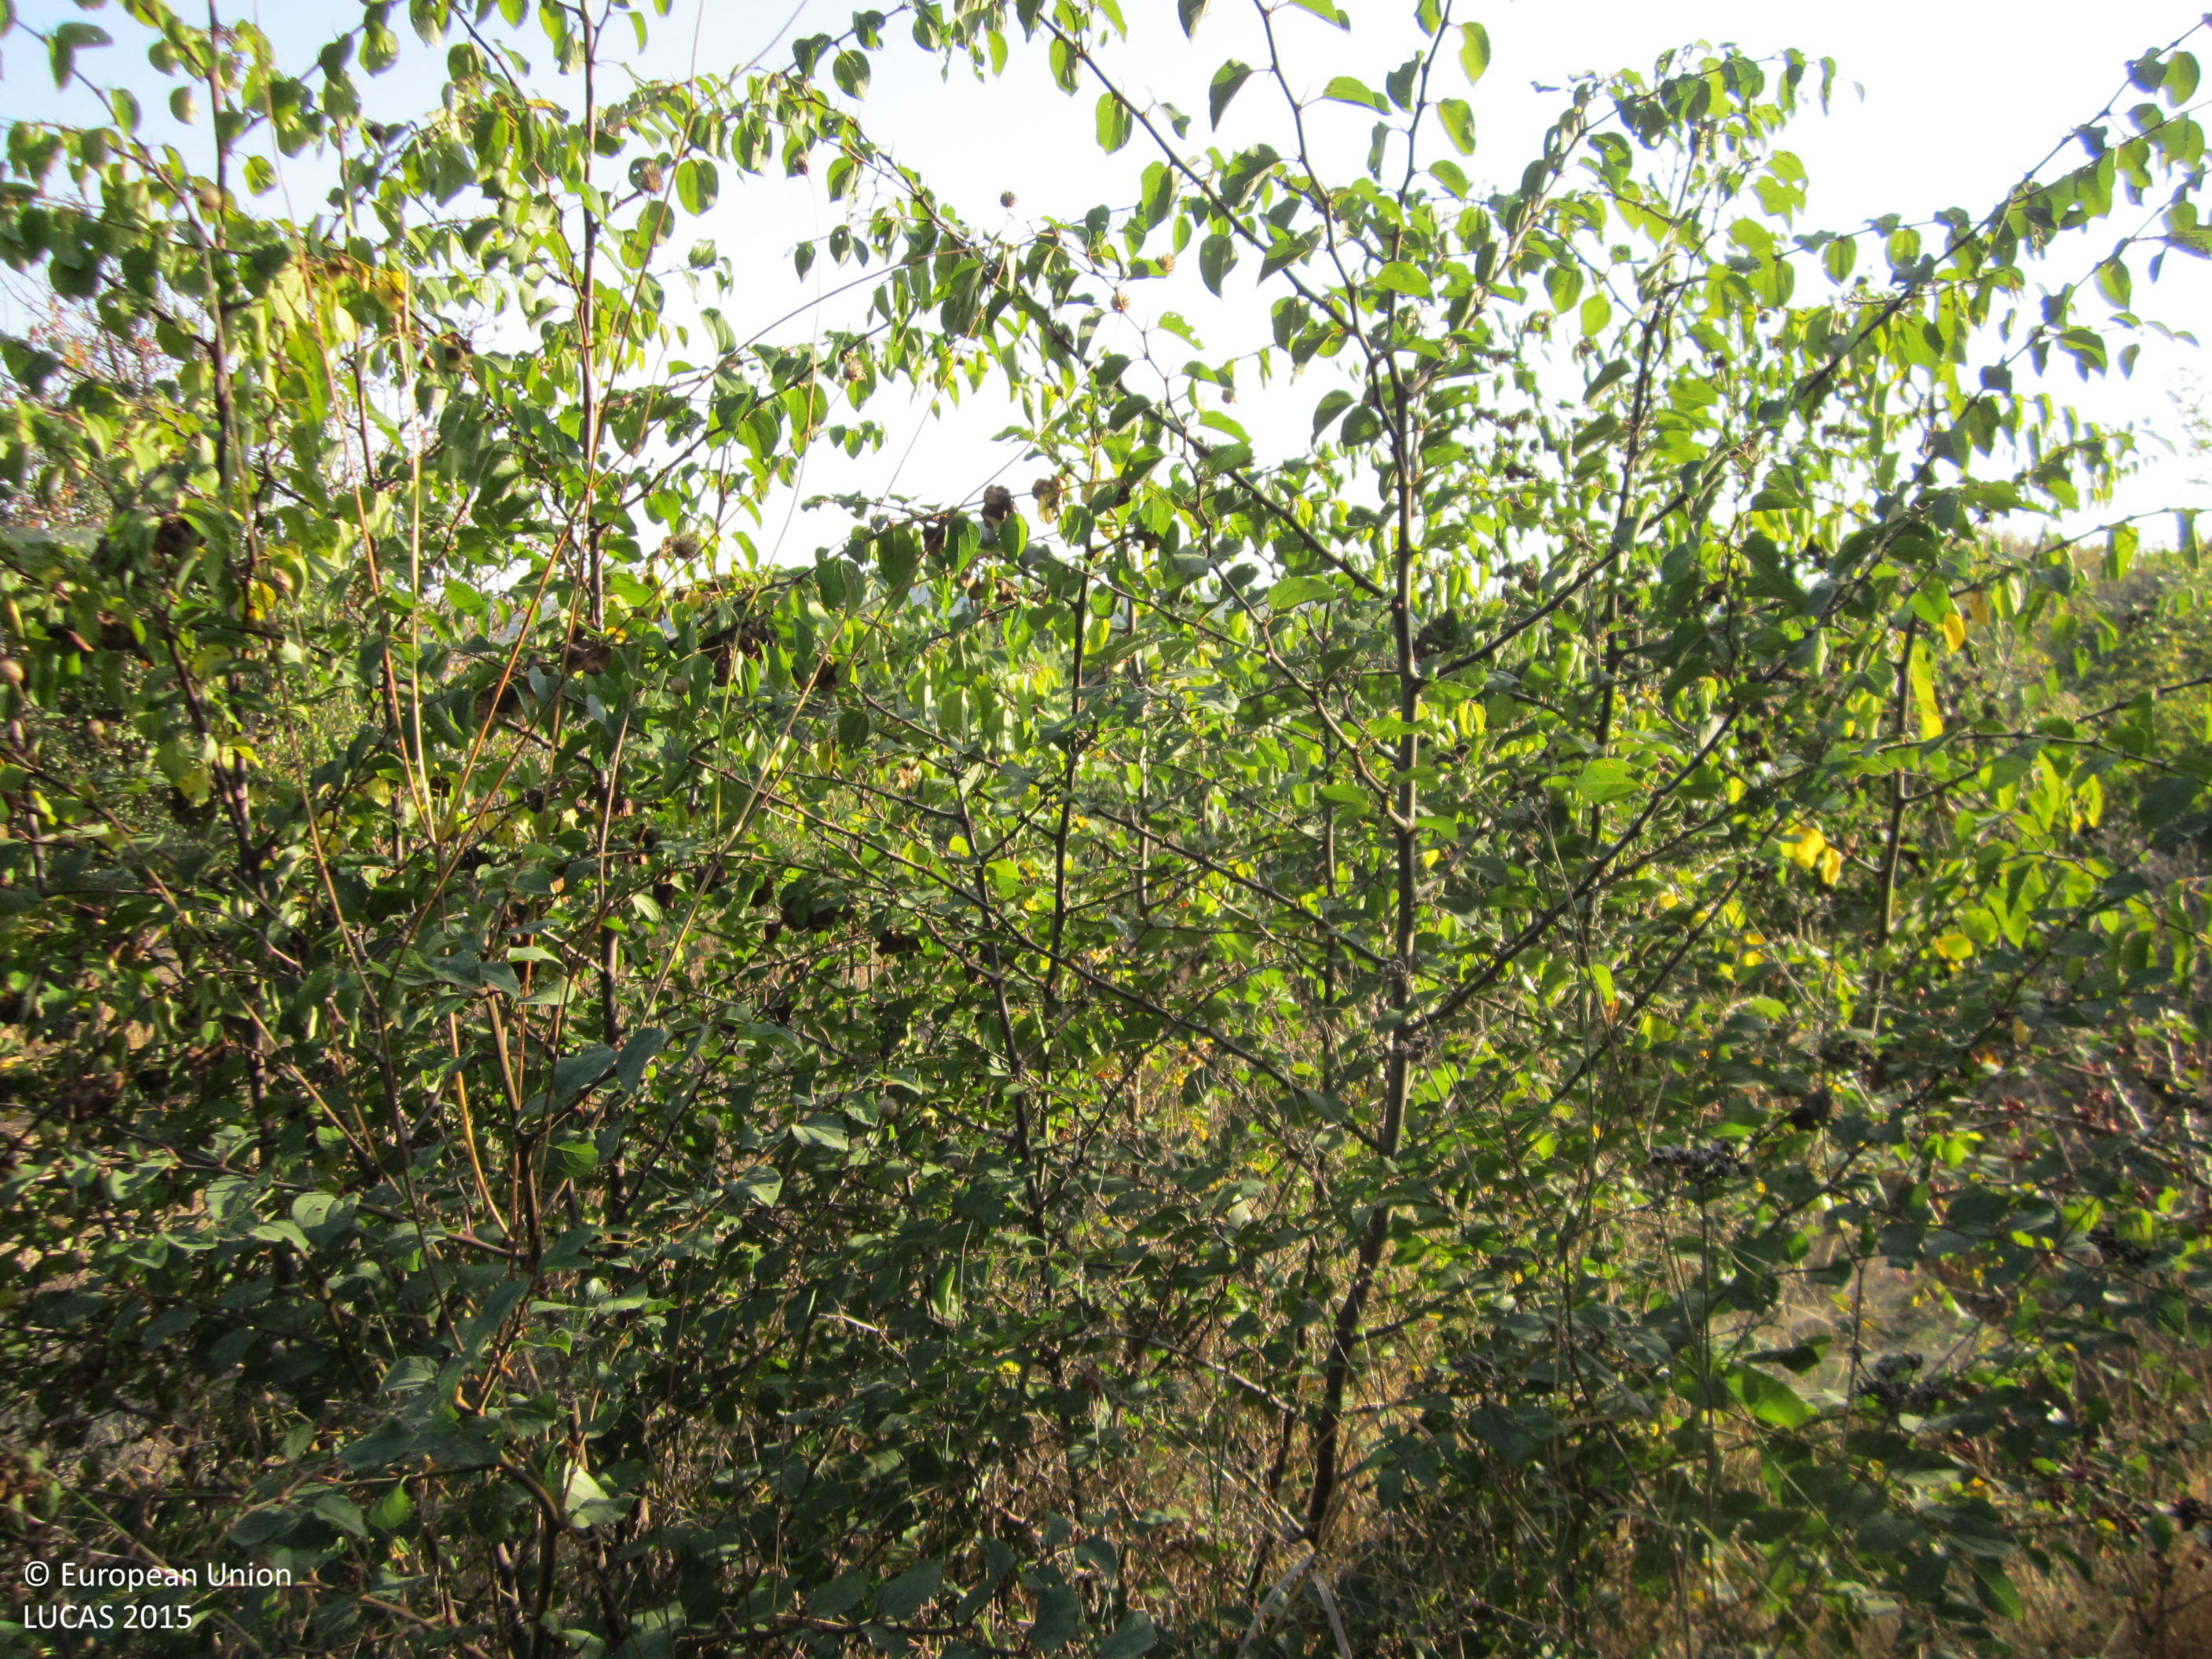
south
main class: Shrubland
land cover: Shrubland with sparse tree cover
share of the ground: > 75 %
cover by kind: shrubs 80 %, herbaceous plants 15 %, broadleaved forest trees 5 %
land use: Semi-natural and natural areas not in use
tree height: < 5 m
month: September
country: BG
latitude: 42.6630
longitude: 27.4053
